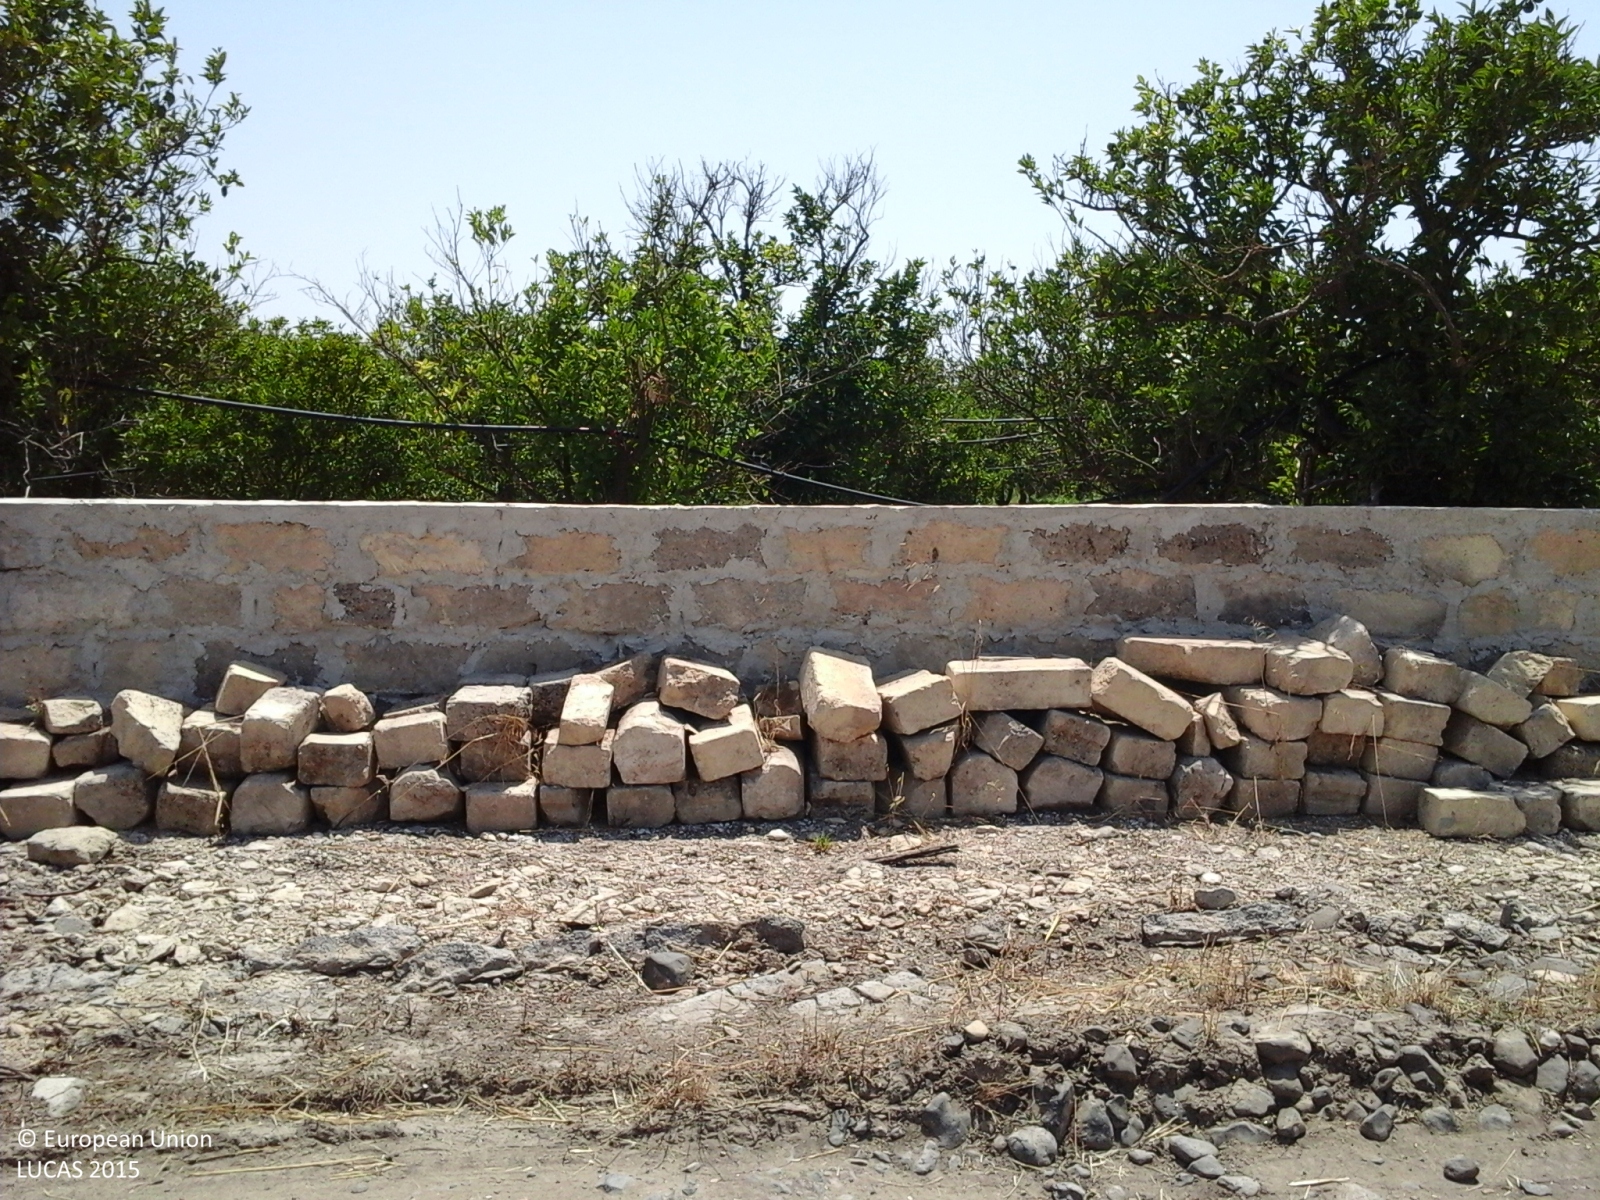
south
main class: Cropland
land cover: Oranges
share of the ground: > 75 %
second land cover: Spontaneously vegetated surfaces
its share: > 75 %
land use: Agriculture (excluding fallow land and kitchen gardens)
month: August
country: IT
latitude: 37.3123
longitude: 14.8944
